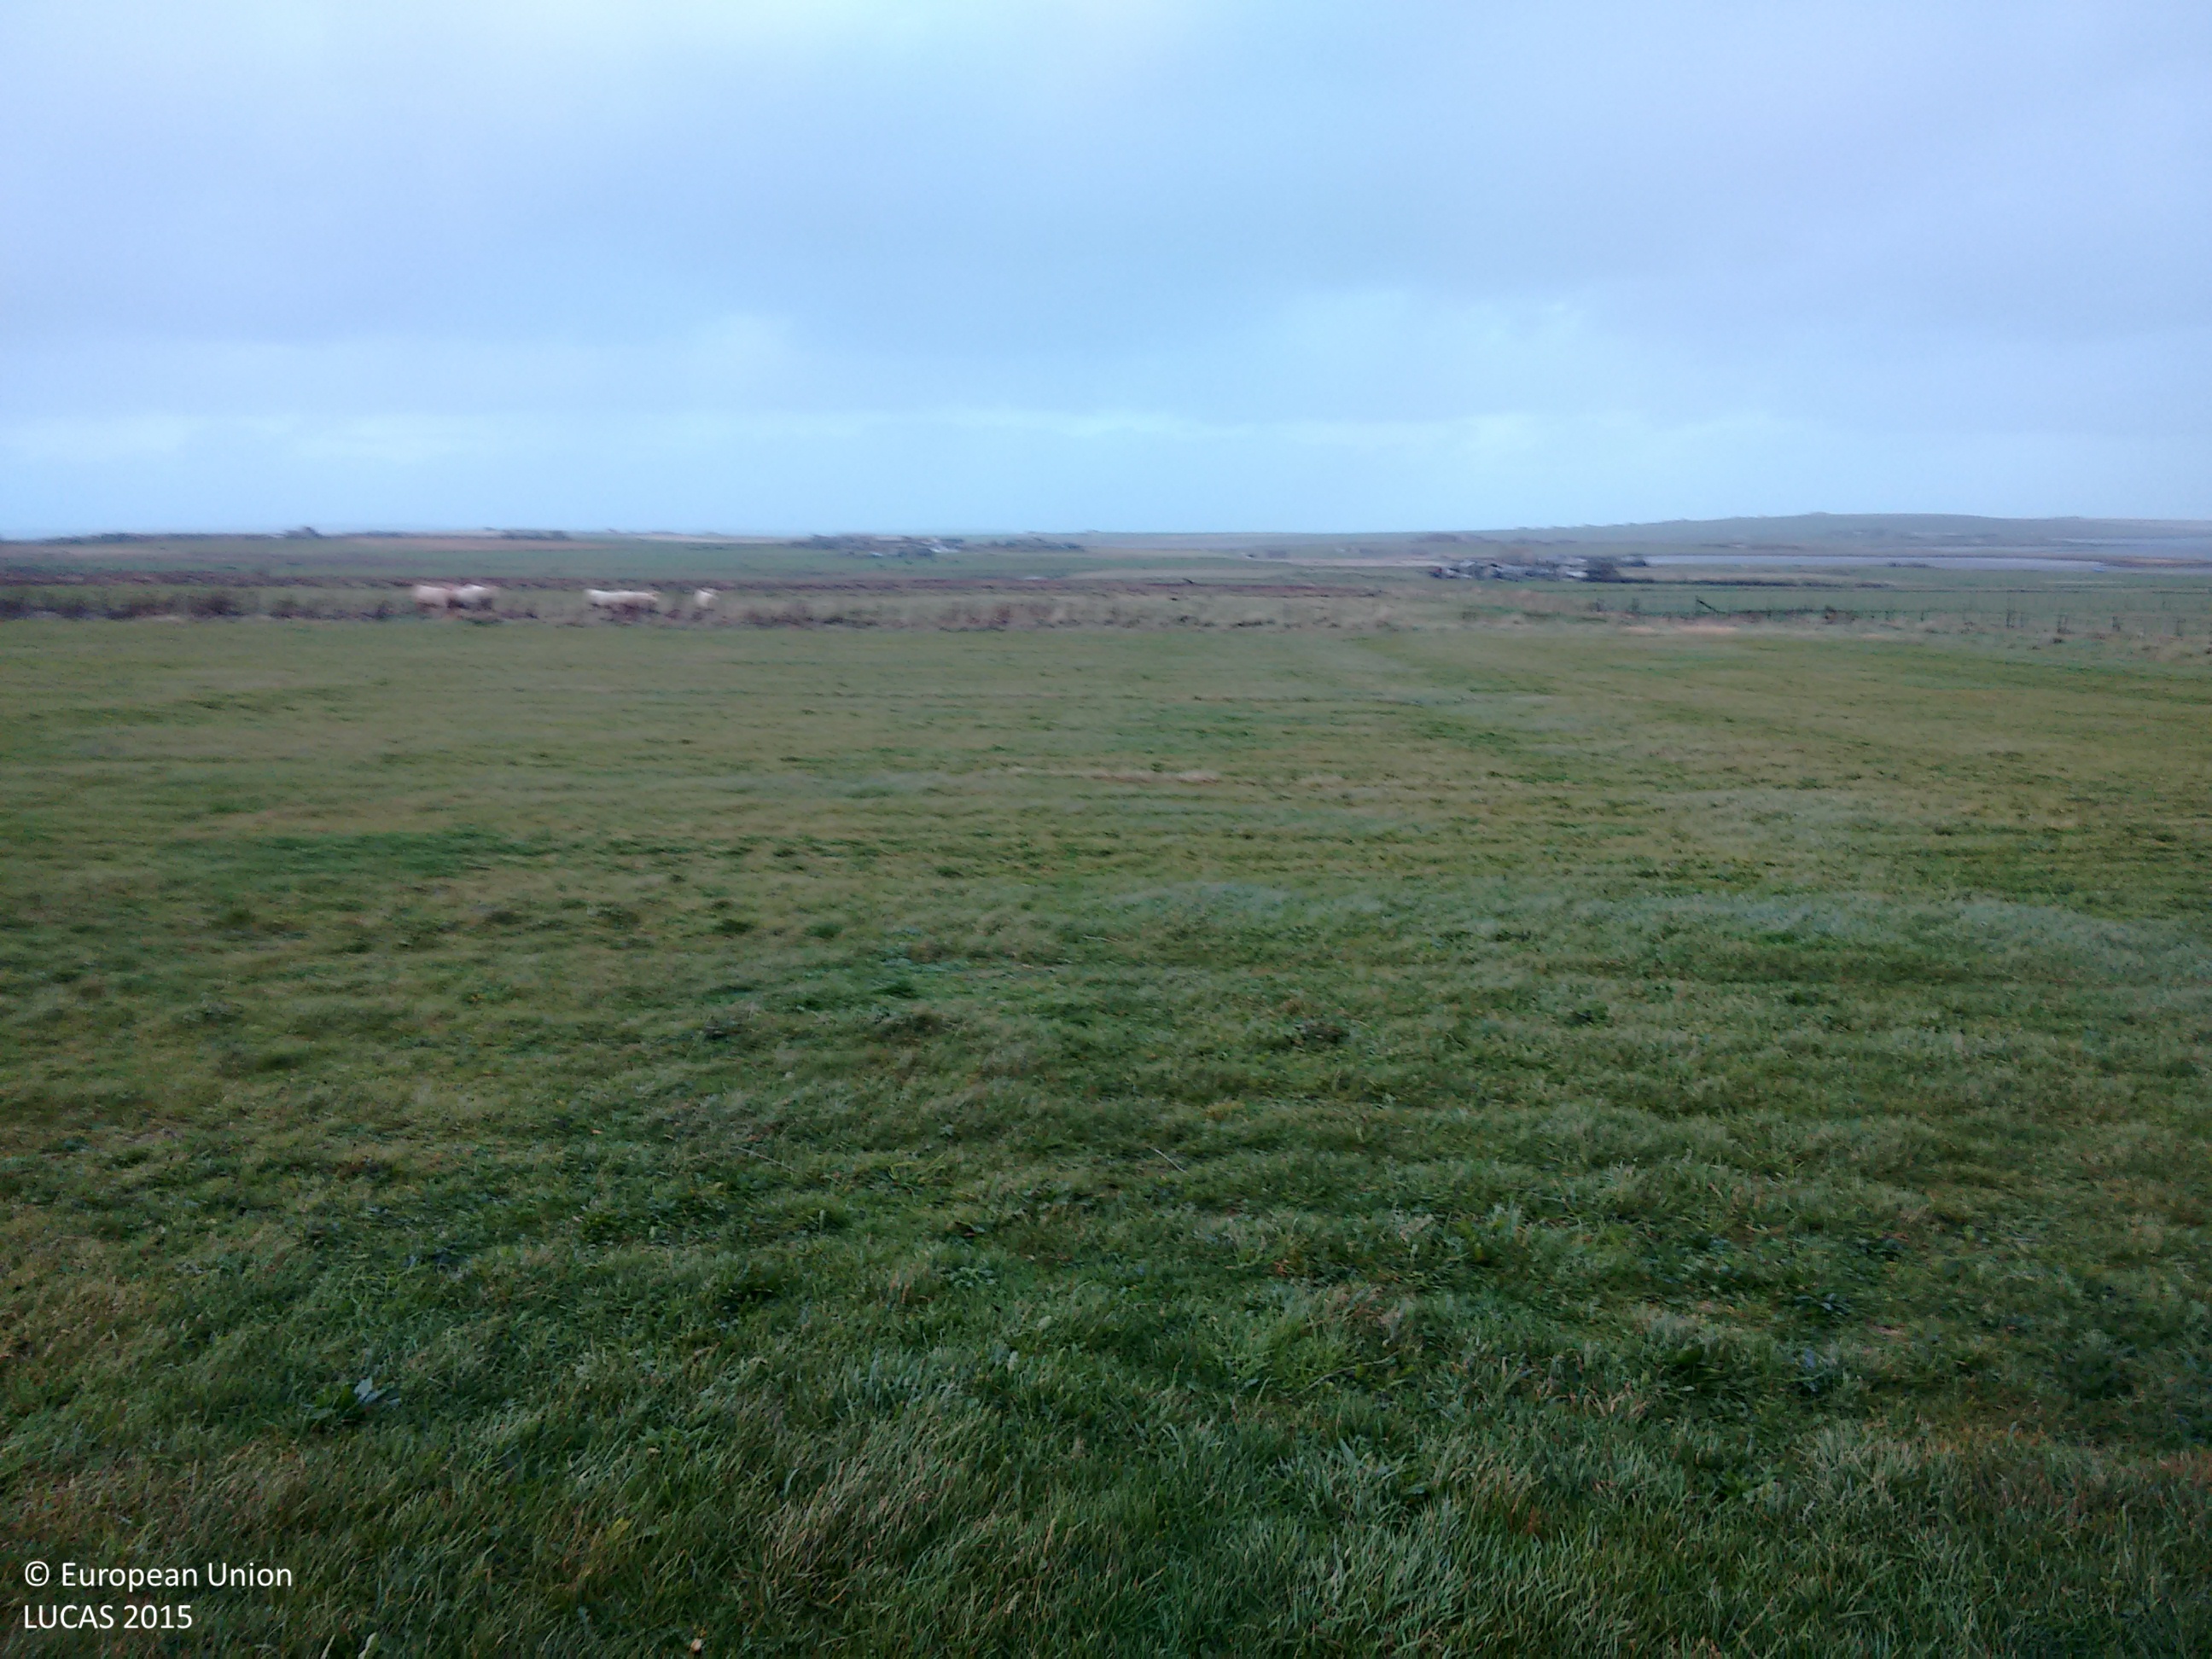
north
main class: Grassland
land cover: Grassland without tree/shrub cover
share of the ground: > 75 %
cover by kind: herbaceous plants 100 %
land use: Agriculture (excluding fallow land and kitchen gardens)
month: November
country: GB
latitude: 58.9493
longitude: -2.8608
